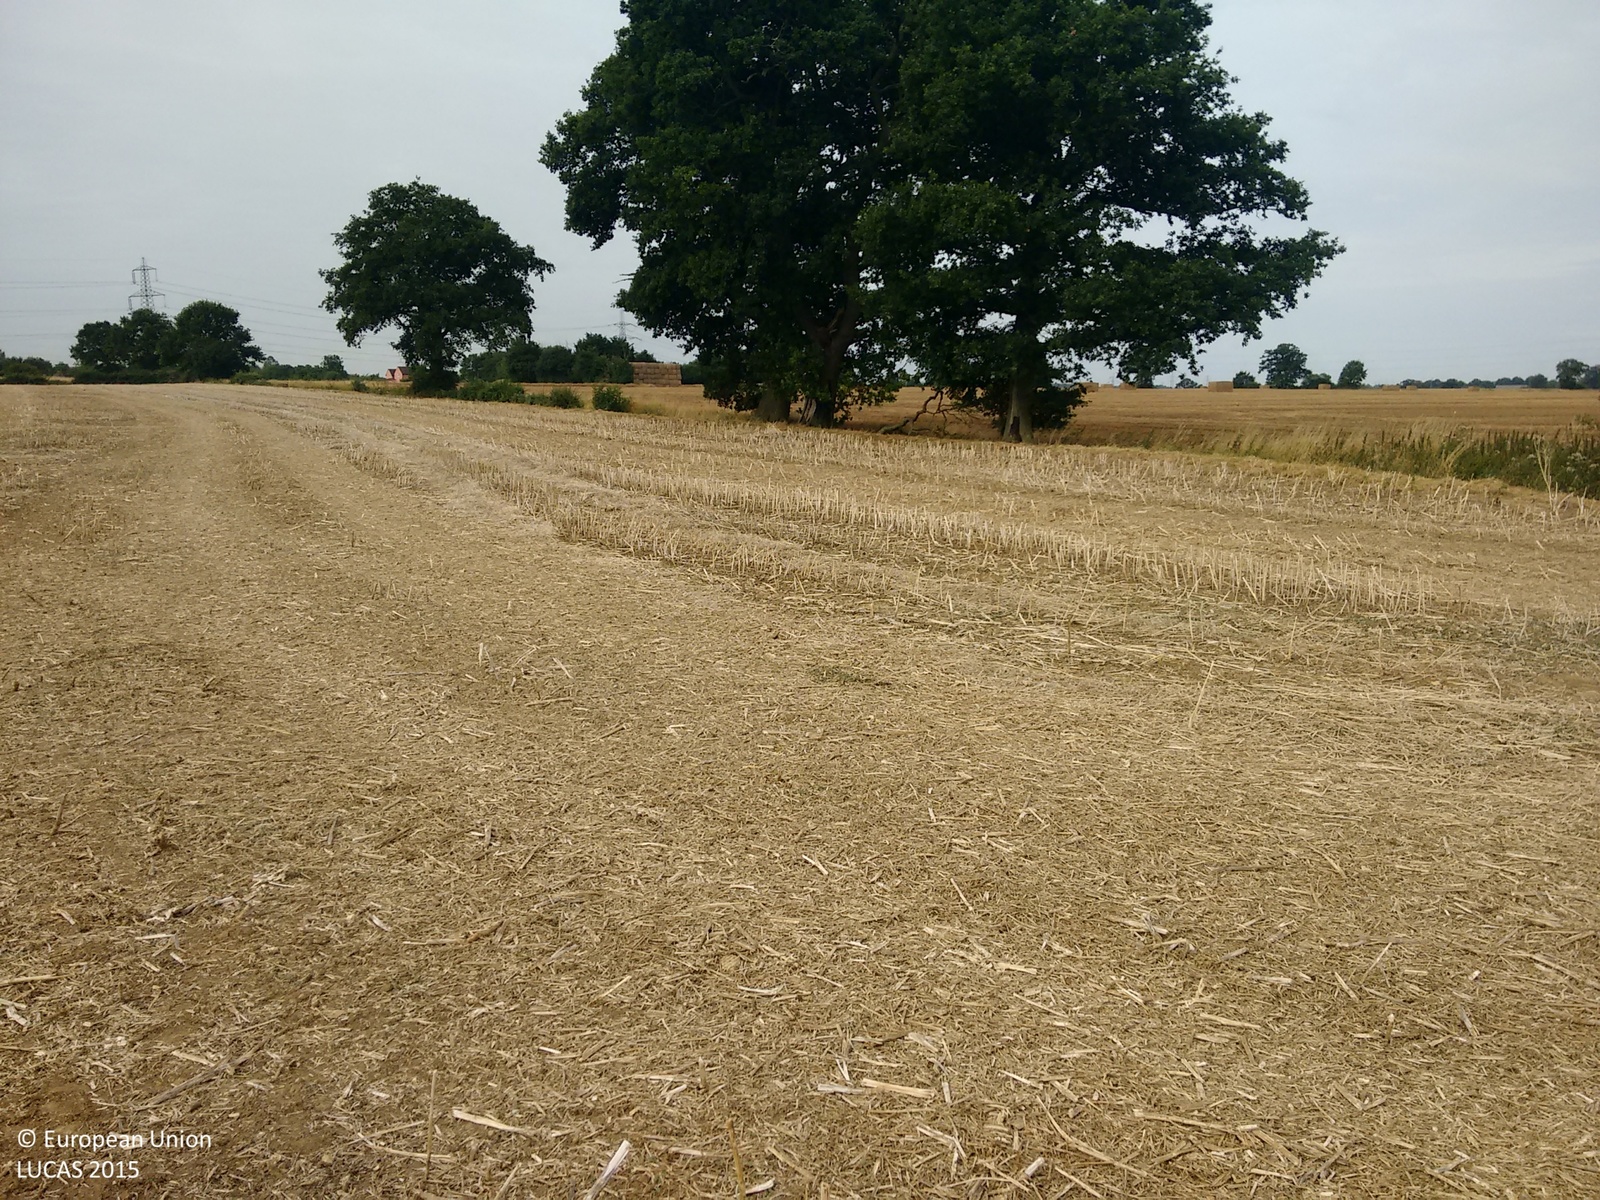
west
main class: Cropland
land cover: Rape and turnip rape
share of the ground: < 10 %
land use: Agriculture (excluding fallow land and kitchen gardens)
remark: Harvested field
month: August
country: GB
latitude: 52.0043
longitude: 0.6065
